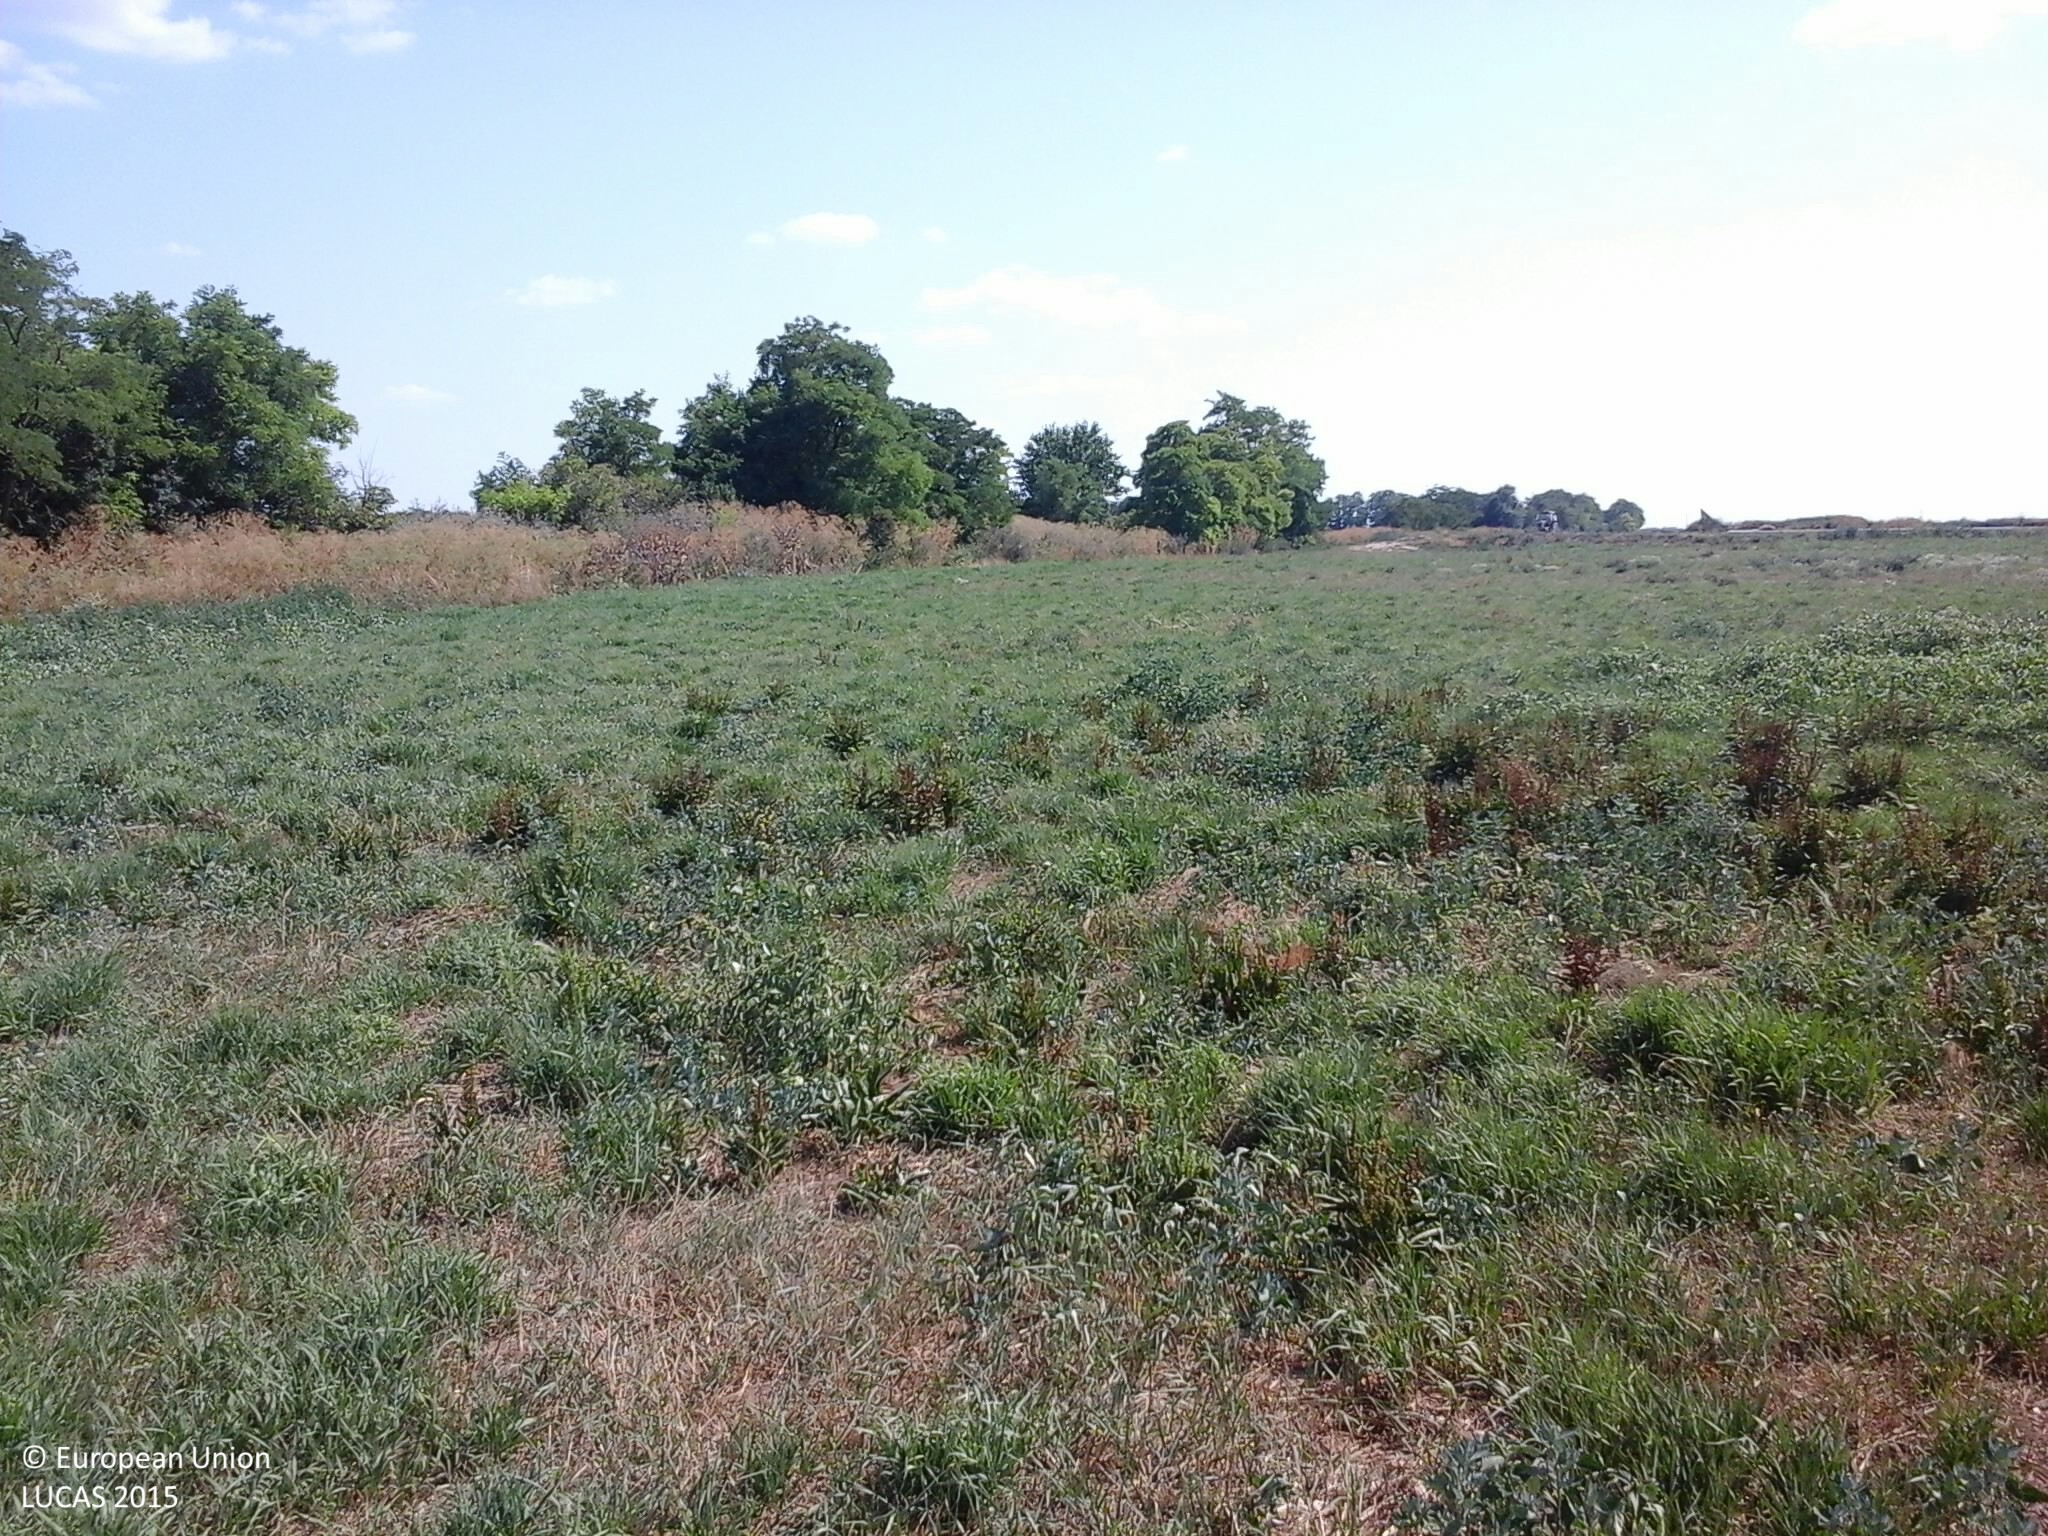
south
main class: Grassland
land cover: Spontaneously vegetated surfaces
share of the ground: > 75 %
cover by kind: herbaceous plants 90 %, unconsolidated bare surface 10 %
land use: Fallow land
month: July
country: HU
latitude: 47.0365
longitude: 18.3681
